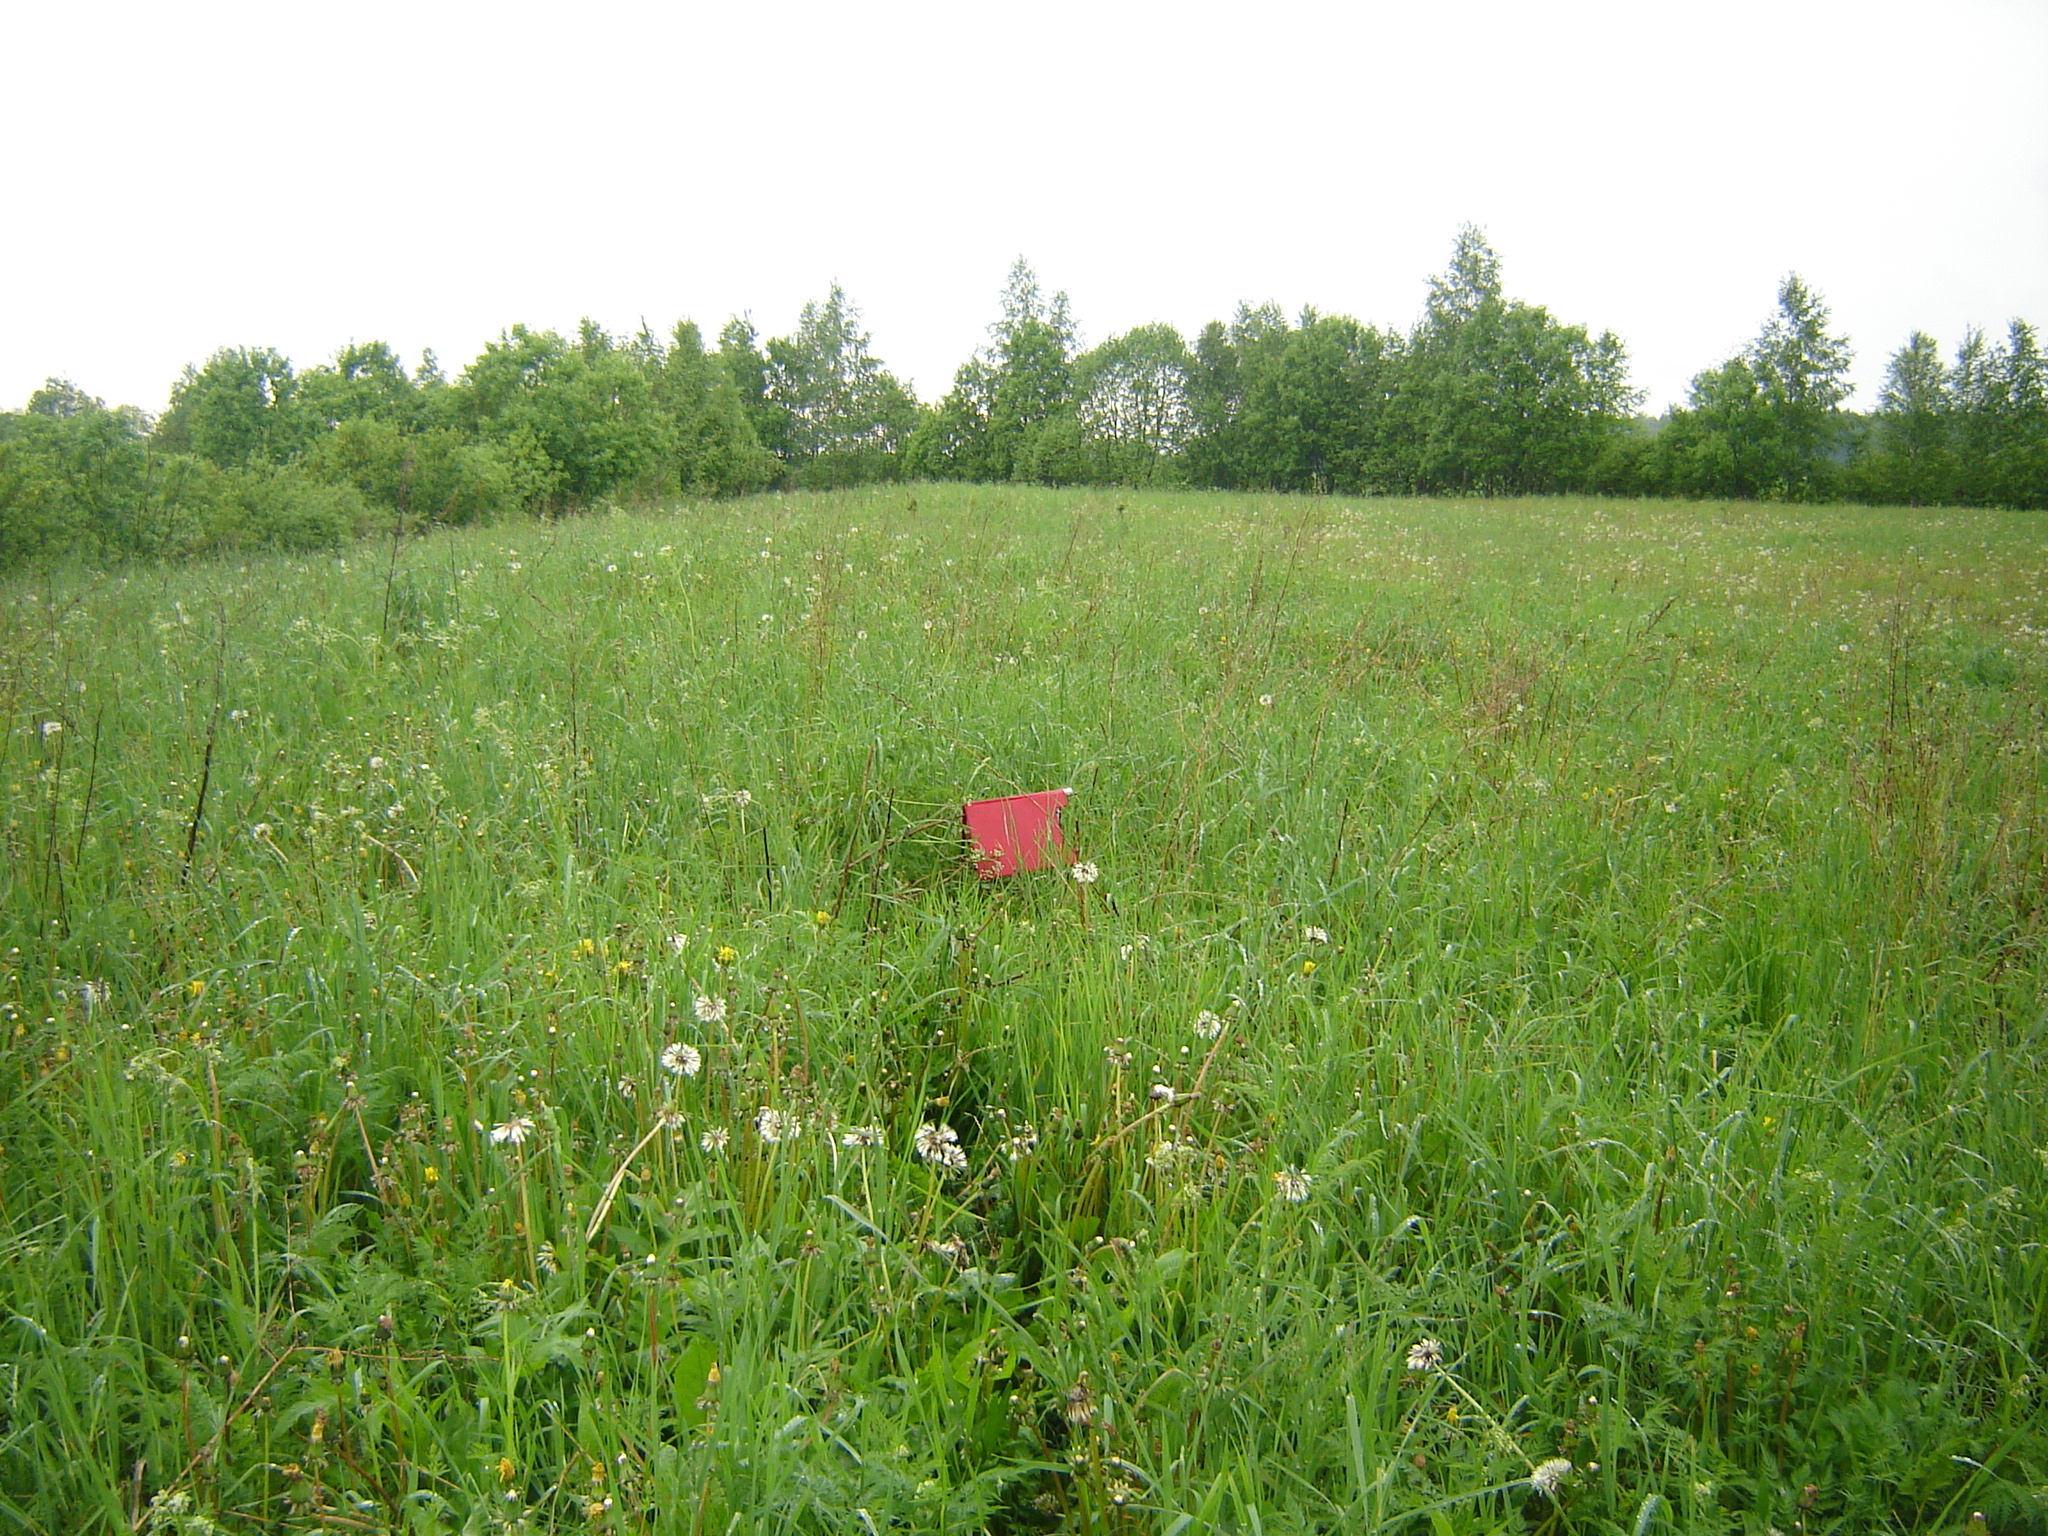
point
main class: Grassland
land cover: Grassland without tree/shrub cover
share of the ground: > 75 %
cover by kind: herbaceous plants 100 %
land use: Agriculture (excluding fallow land and kitchen gardens)
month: May
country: LT
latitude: 55.8946
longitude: 25.2276
